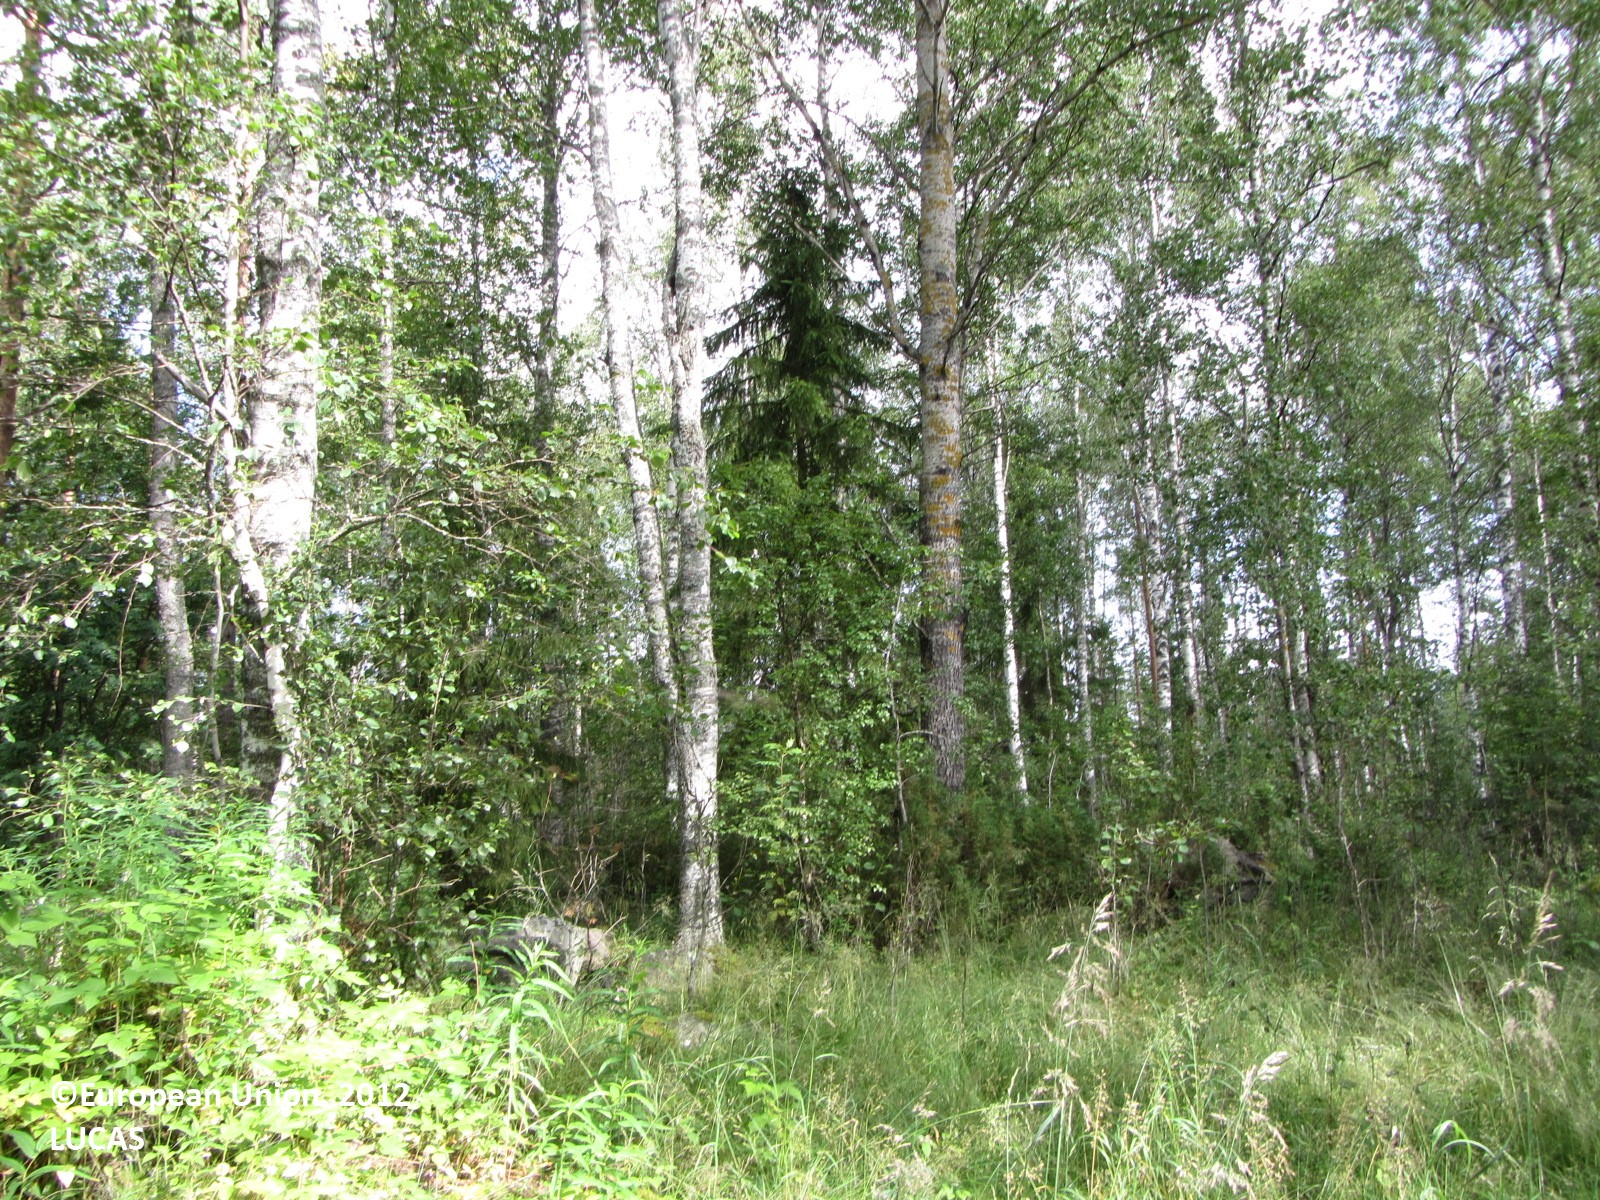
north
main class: Woodland
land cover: Broadleaved woodland
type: boreal forest
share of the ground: 50 - 75 %
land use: Forestry
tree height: > 5 m
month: July
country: FI
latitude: 63.8591
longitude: 24.6657
